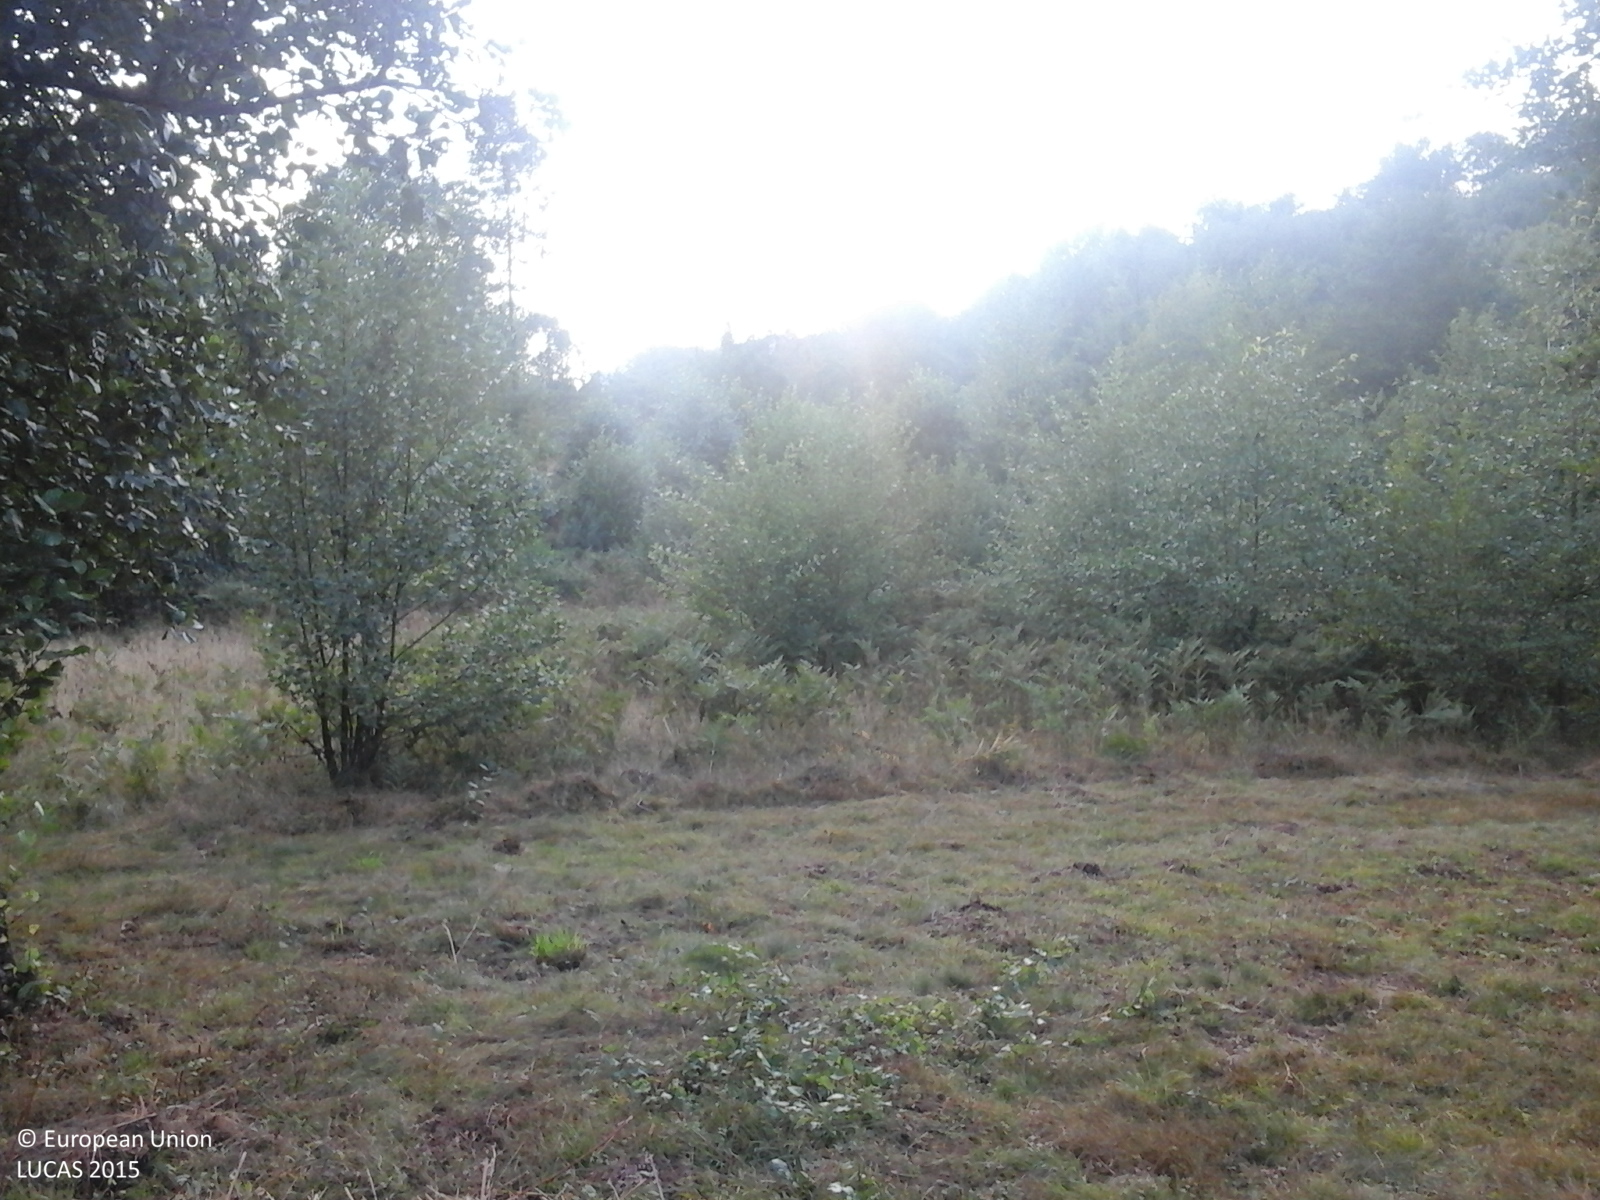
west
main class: Grassland
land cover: Grassland with sparse tree/shrub cover
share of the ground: > 75 %
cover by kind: herbaceous plants 85 %, shrubs 10 %, broadleaved forest trees 5 %
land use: Agriculture (excluding fallow land and kitchen gardens)
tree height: > 5 m
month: September
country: RO
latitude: 47.7831
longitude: 23.8425
